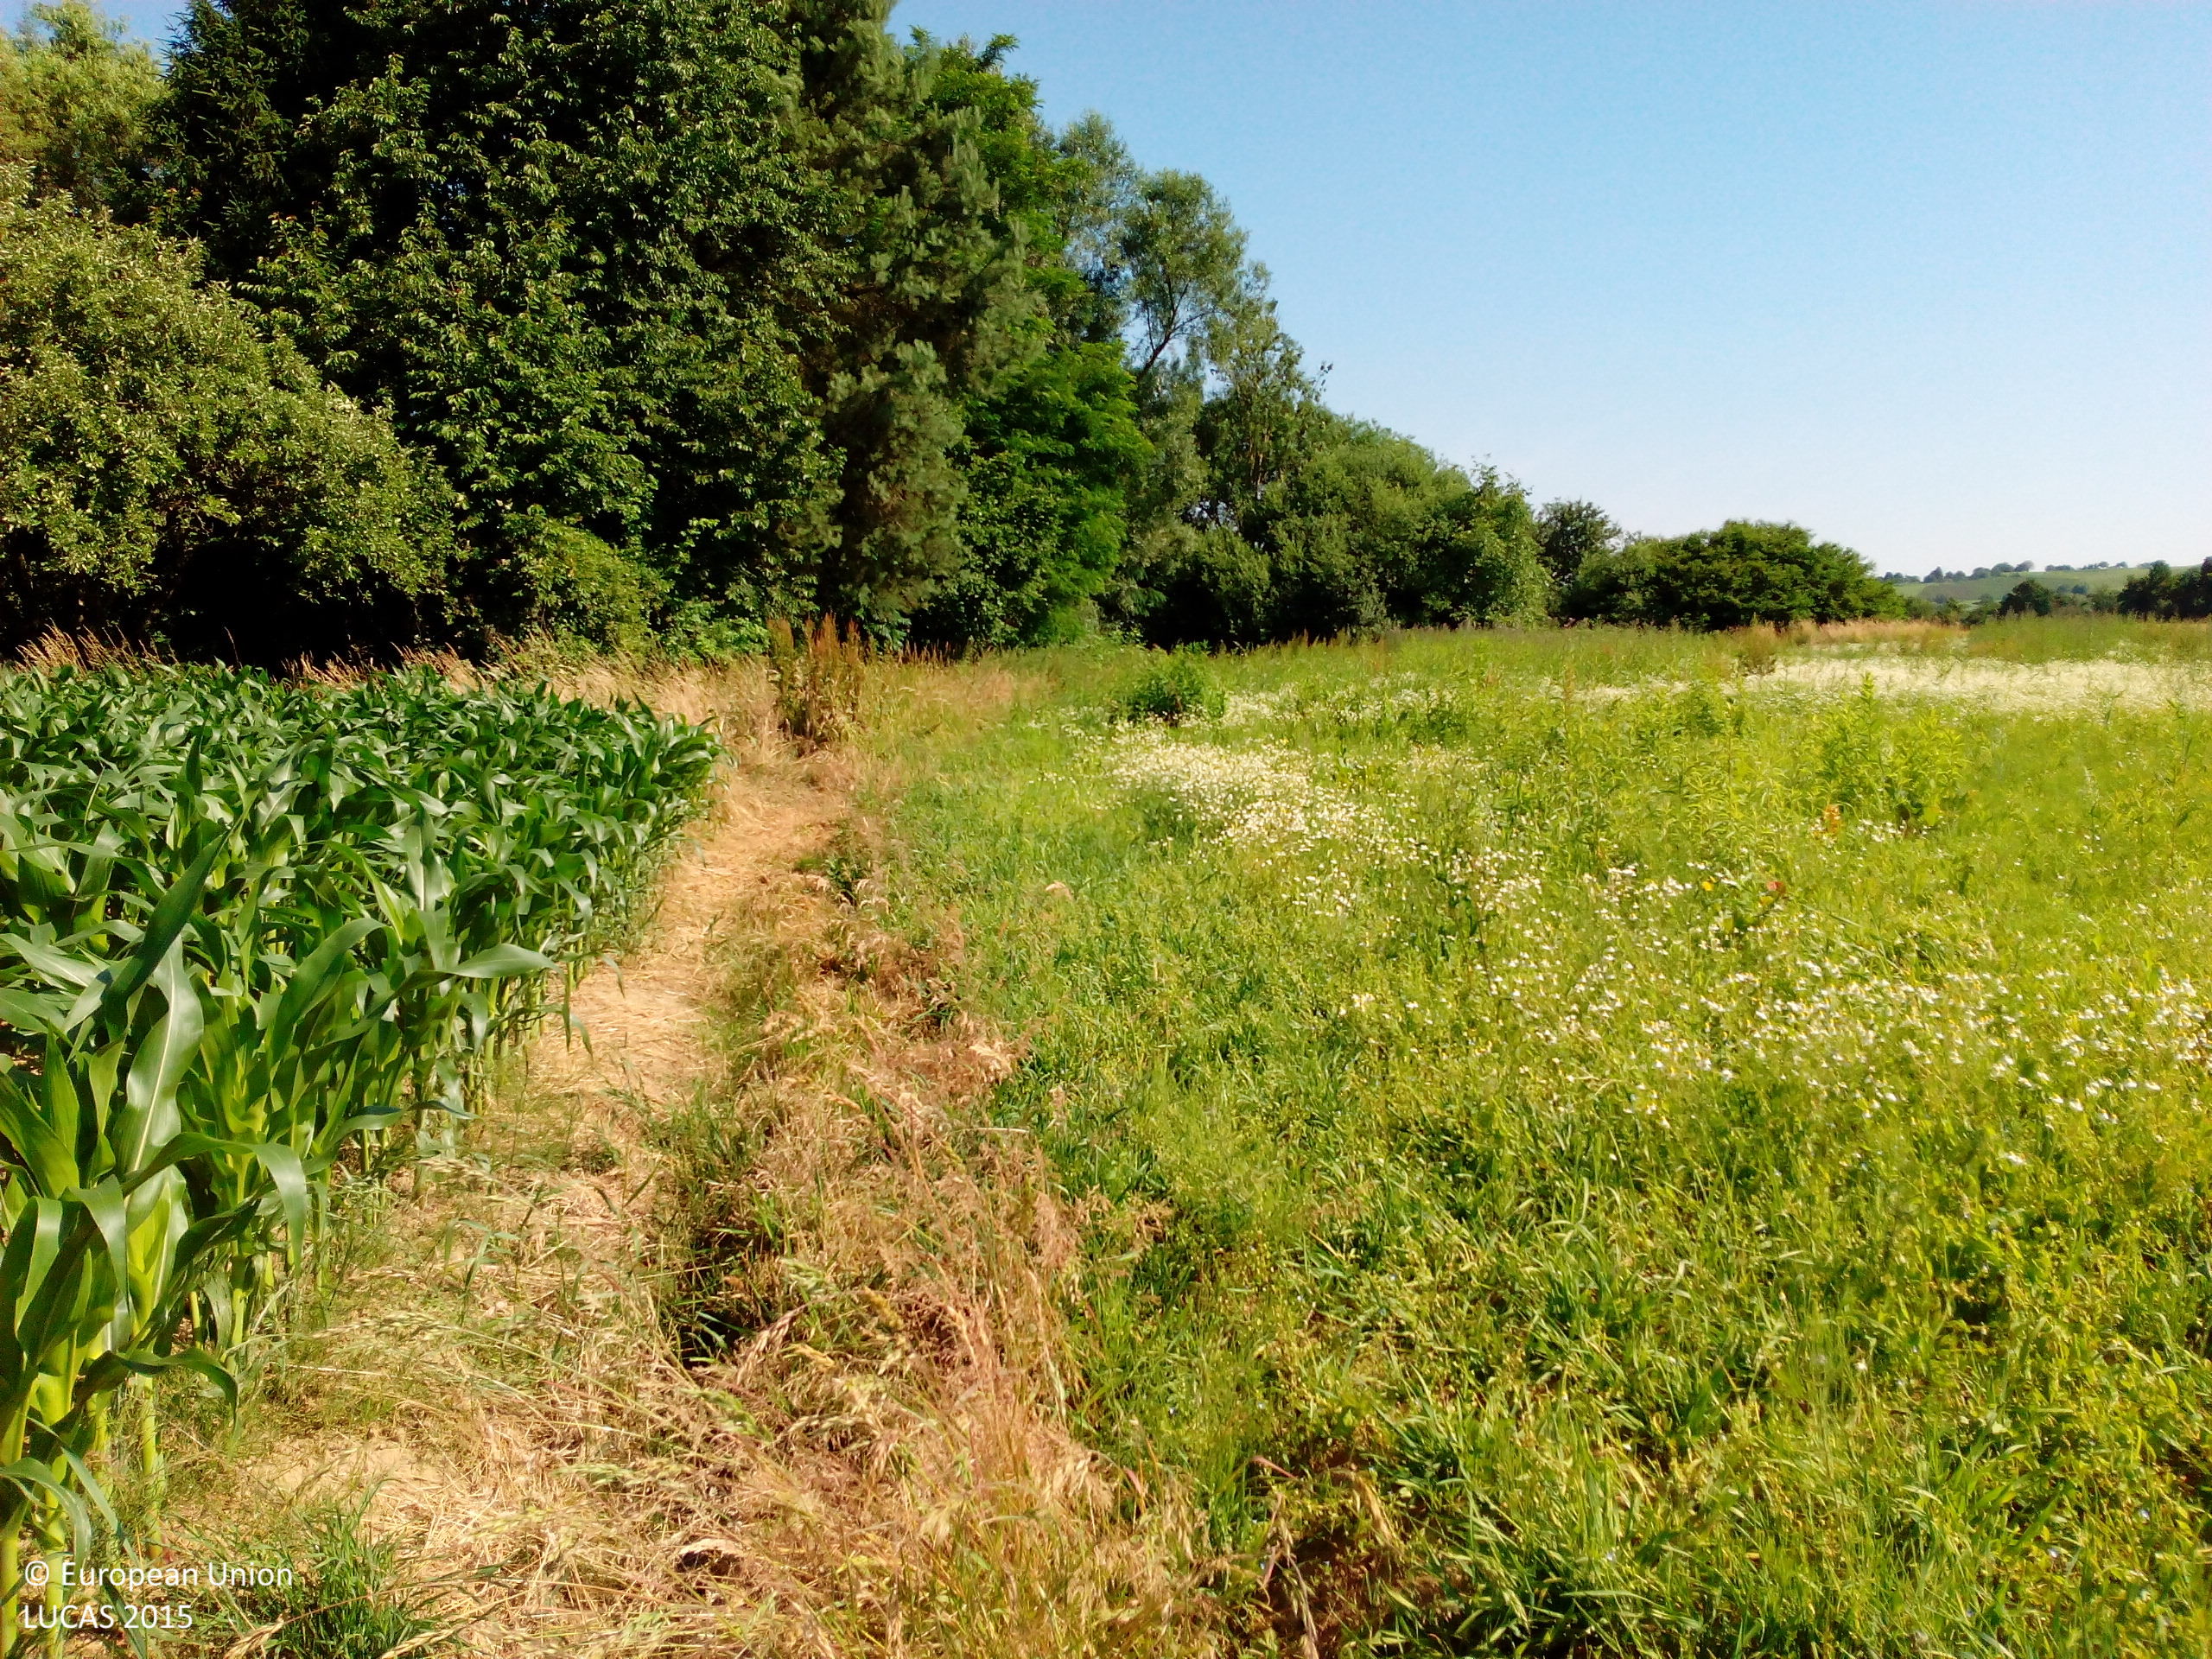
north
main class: Cropland
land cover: Maize
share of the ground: > 75 %
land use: Agriculture (excluding fallow land and kitchen gardens)
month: June
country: DE
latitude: 48.7482
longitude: 8.1647
